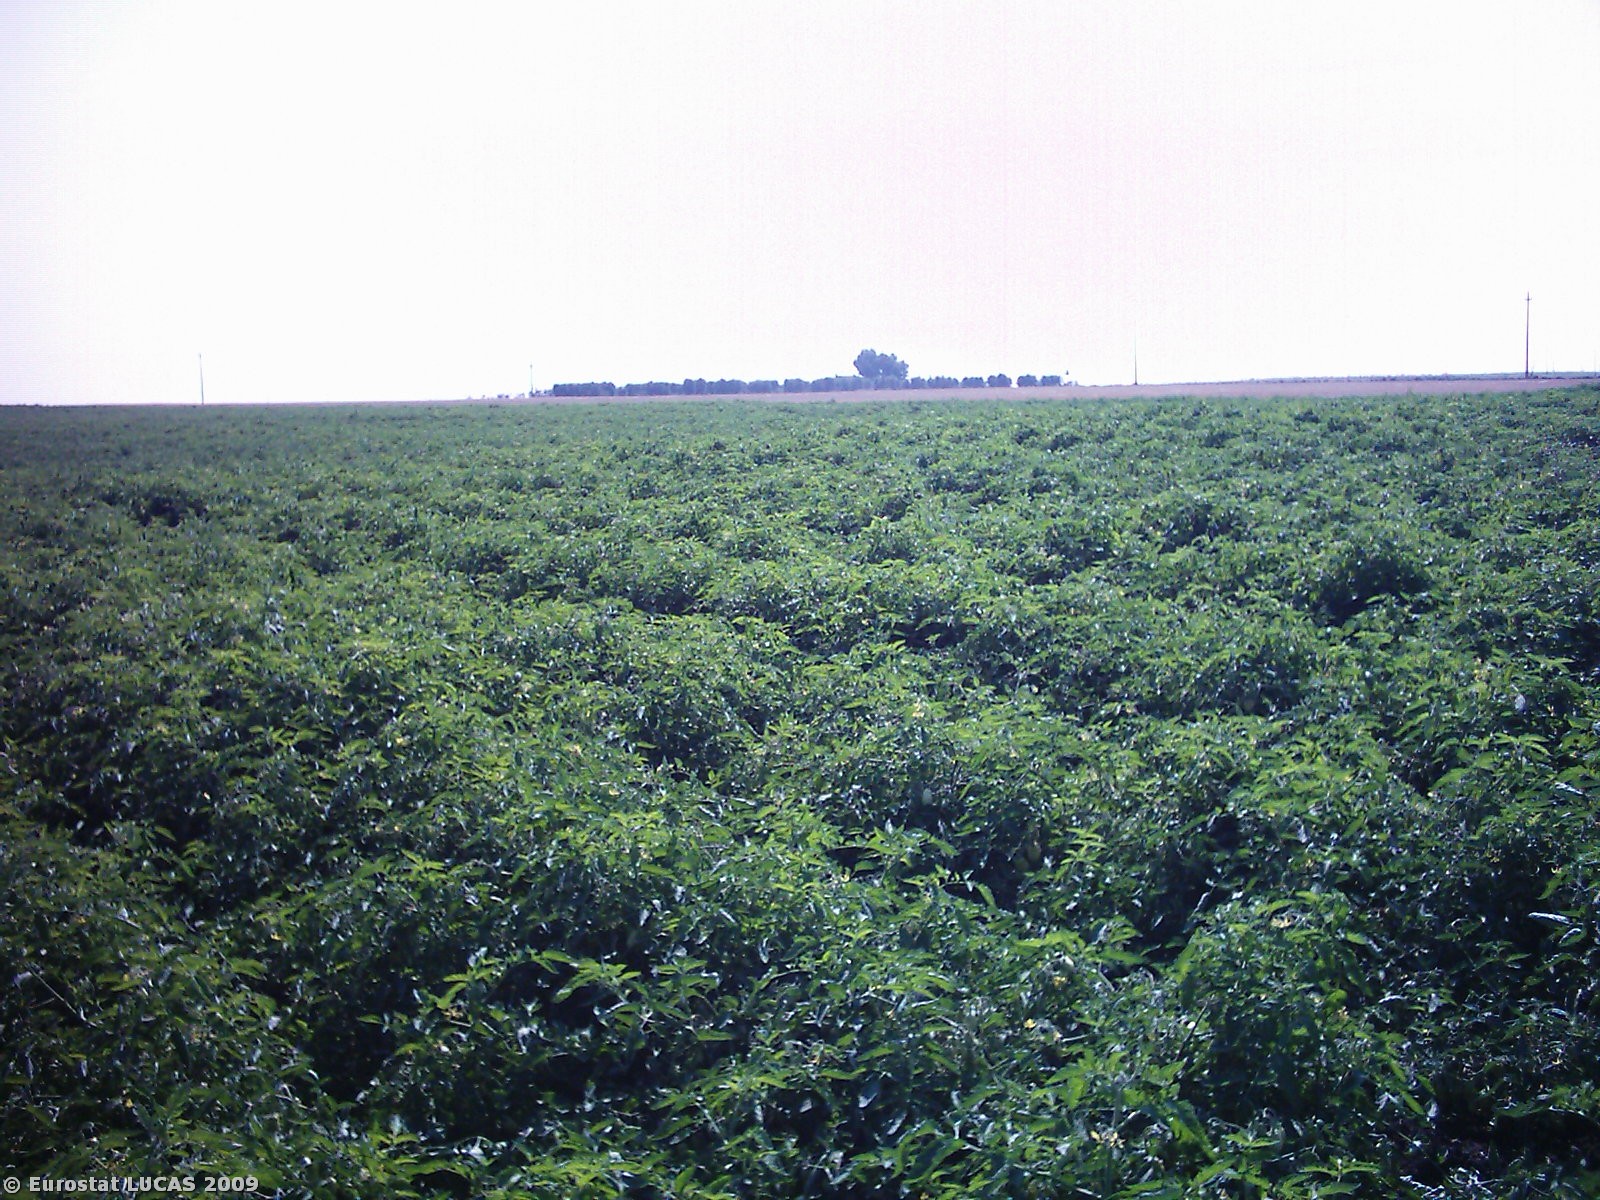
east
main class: Cropland
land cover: Tomatoes
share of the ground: 50 - 75 %
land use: Agriculture (excluding fallow land and kitchen gardens)
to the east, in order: Tomatoes; Durum wheat
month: July
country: IT
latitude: 41.2093
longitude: 15.6694
